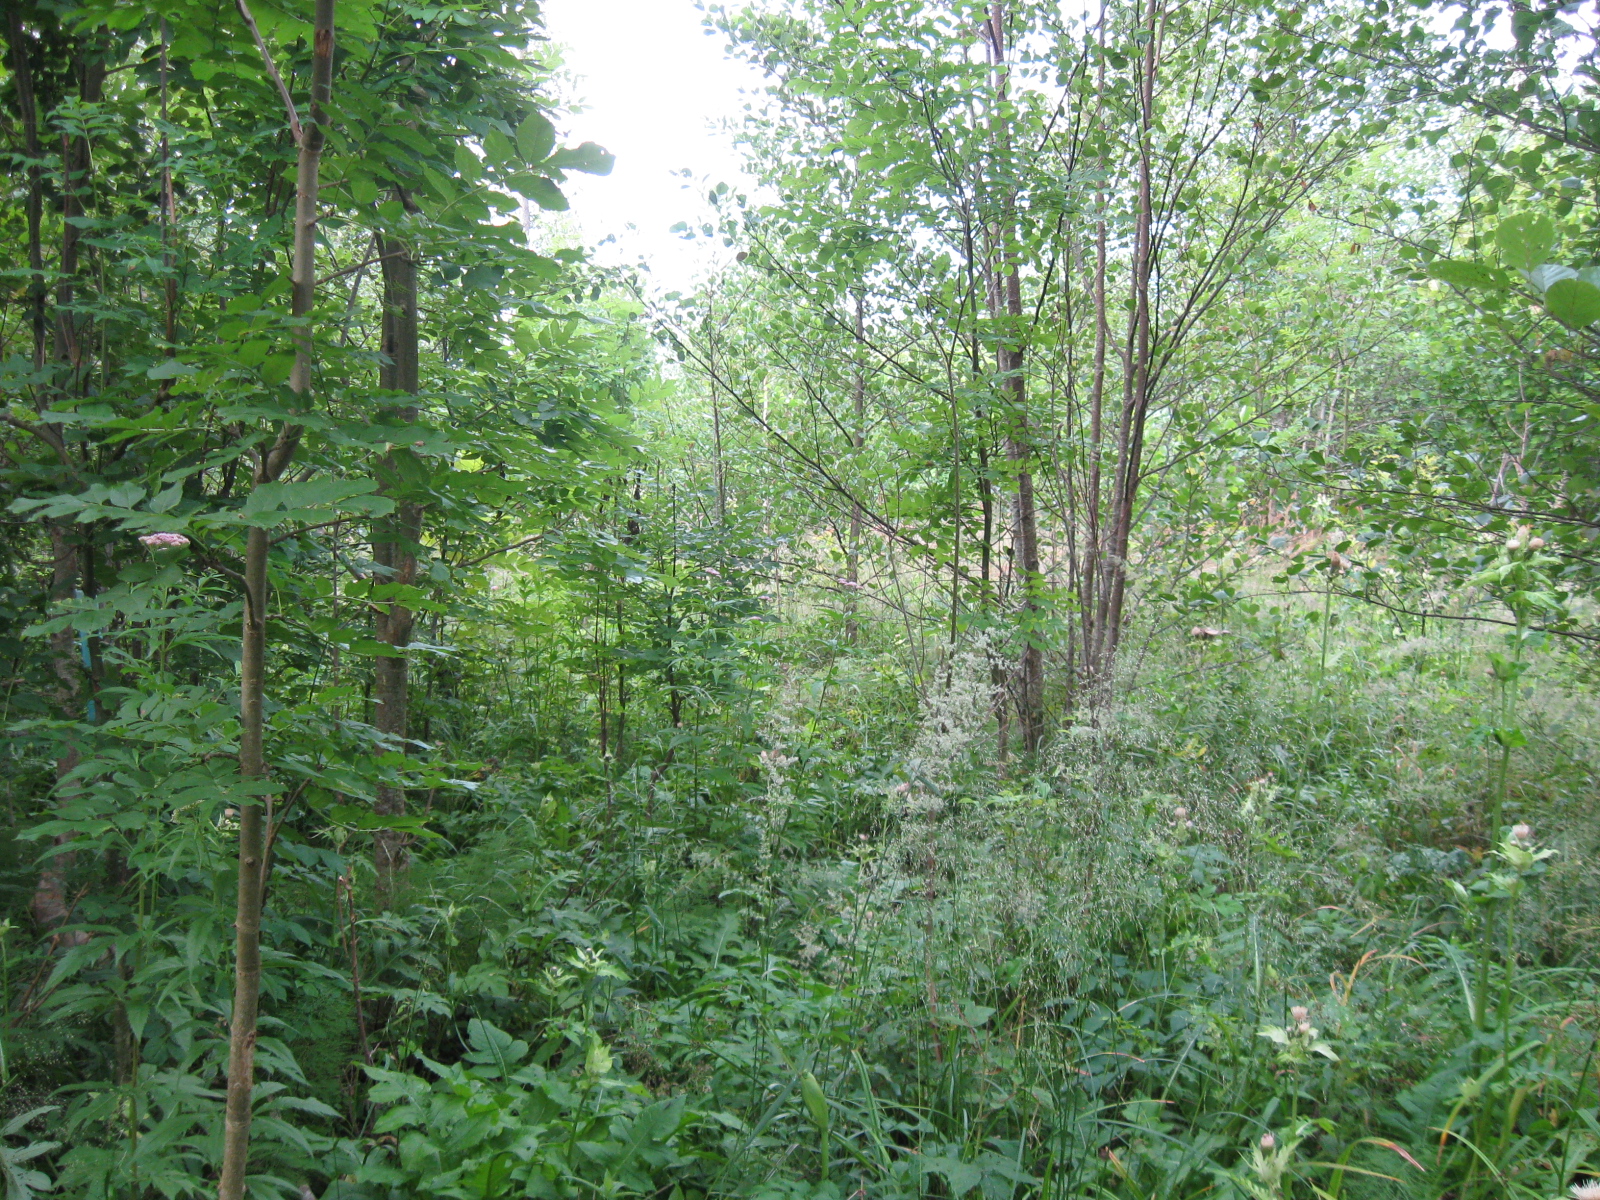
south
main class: Woodland
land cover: Broadleaved woodland
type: mire and swamp forests
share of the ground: > 75 %
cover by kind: broadleaved forest trees 75 %, herbaceous plants 25 %
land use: Forestry
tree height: > 5 m
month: July
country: LT
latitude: 54.4528
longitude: 23.4534
